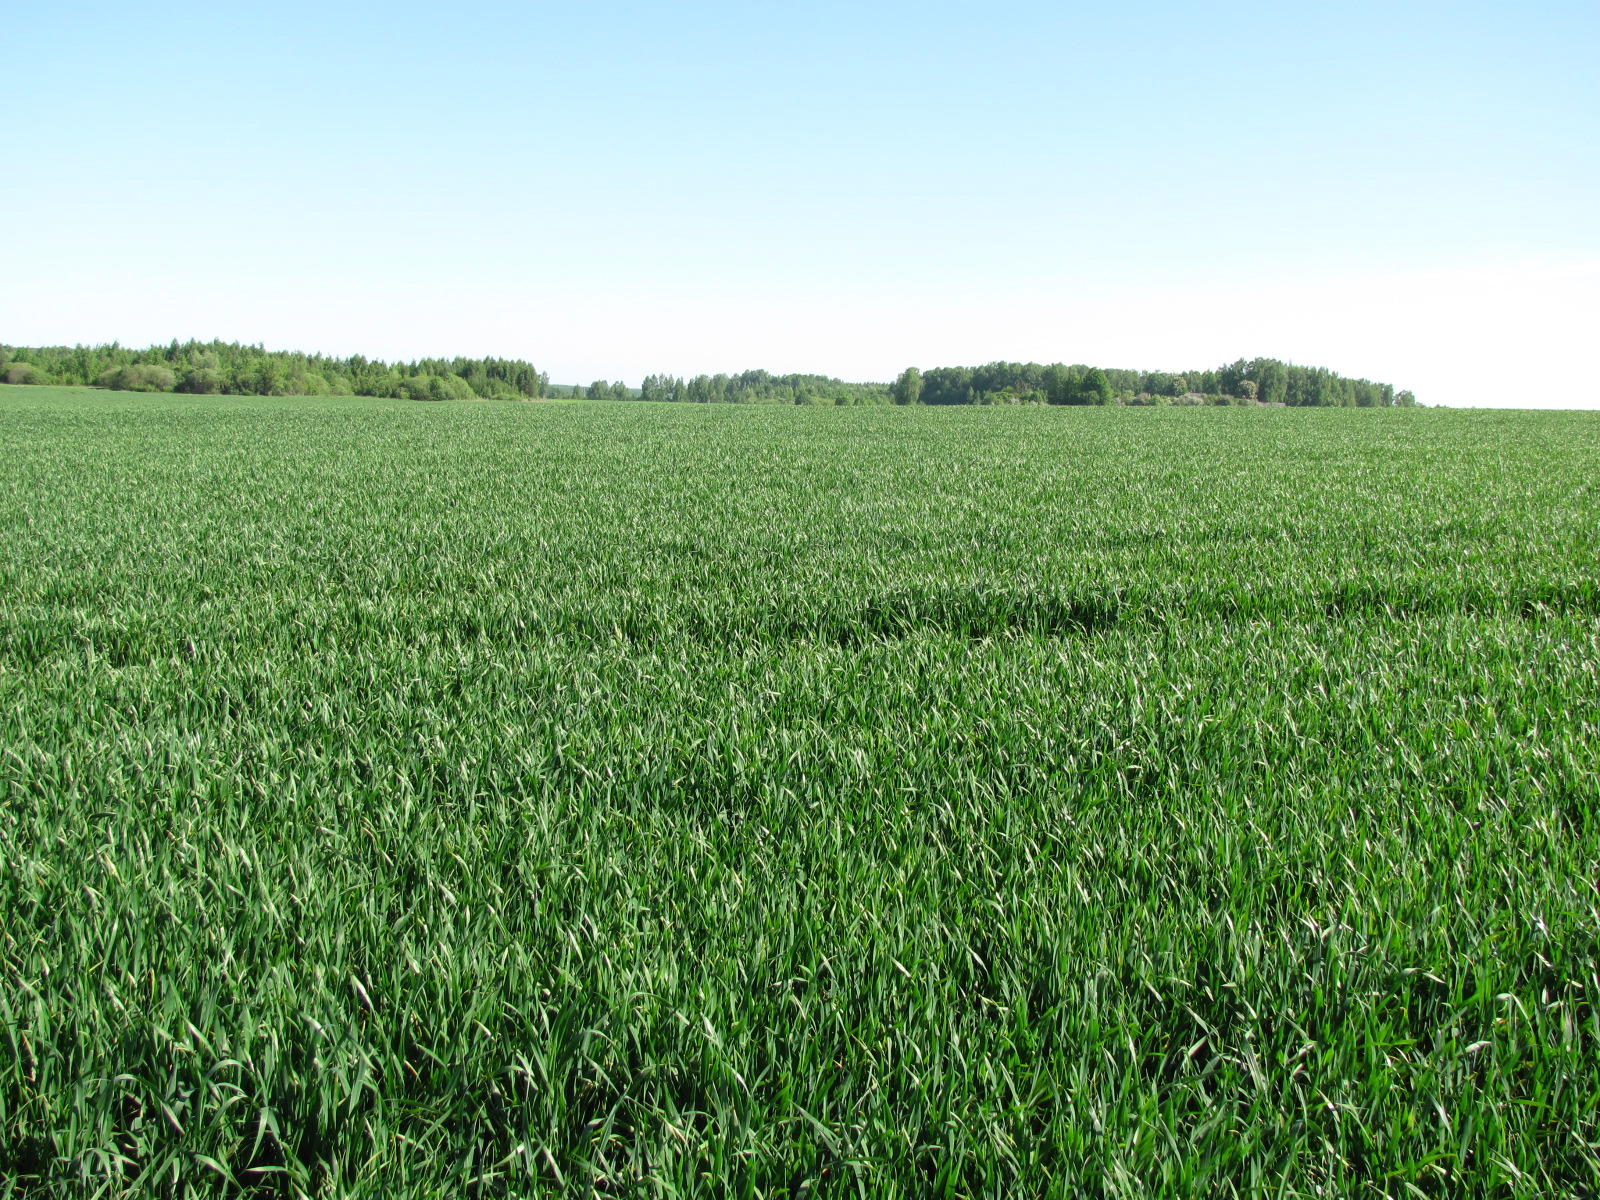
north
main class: Cropland
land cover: Common wheat
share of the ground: > 75 %
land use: Agriculture (excluding fallow land and kitchen gardens)
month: May
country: LV
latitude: 56.5741
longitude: 24.1015
